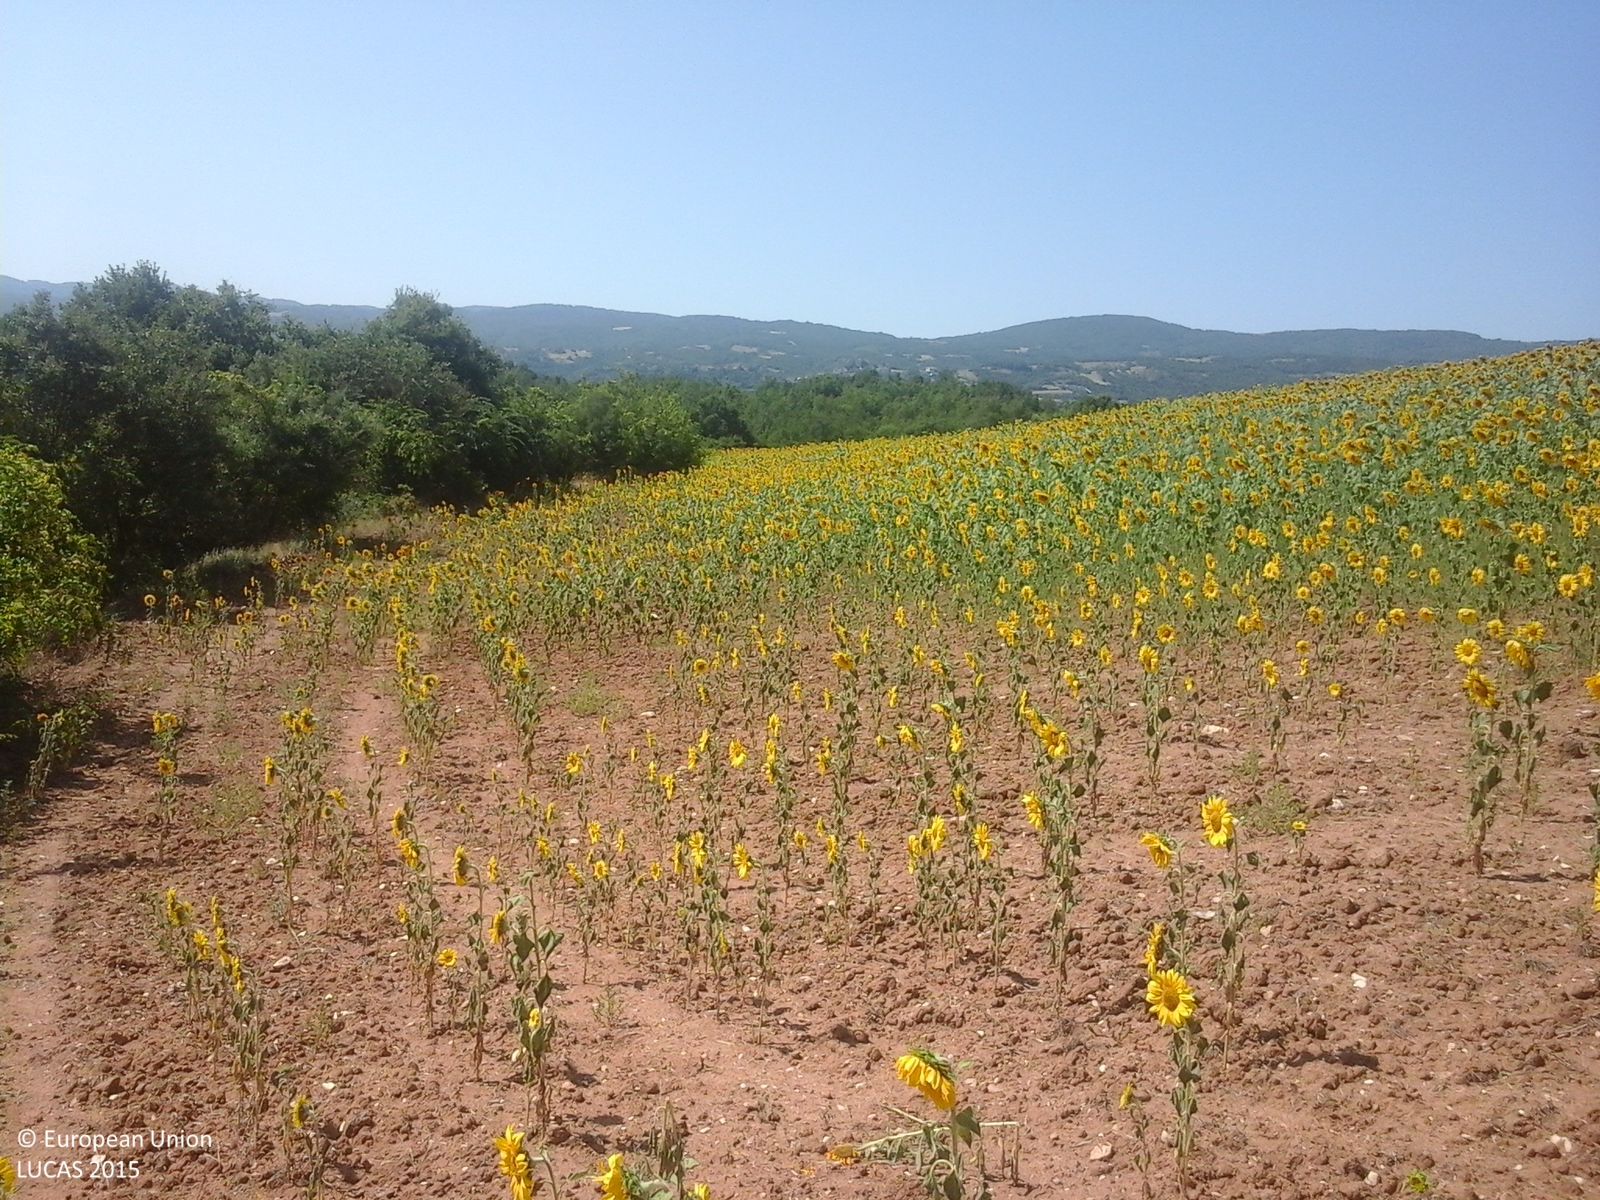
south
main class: Shrubland
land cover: Shrubland without tree cover
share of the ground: > 75 %
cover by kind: shrubs 75 %, herbaceous plants 25 %
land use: Semi-natural and natural areas not in use
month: July
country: GR
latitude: 40.6171
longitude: 23.1895
